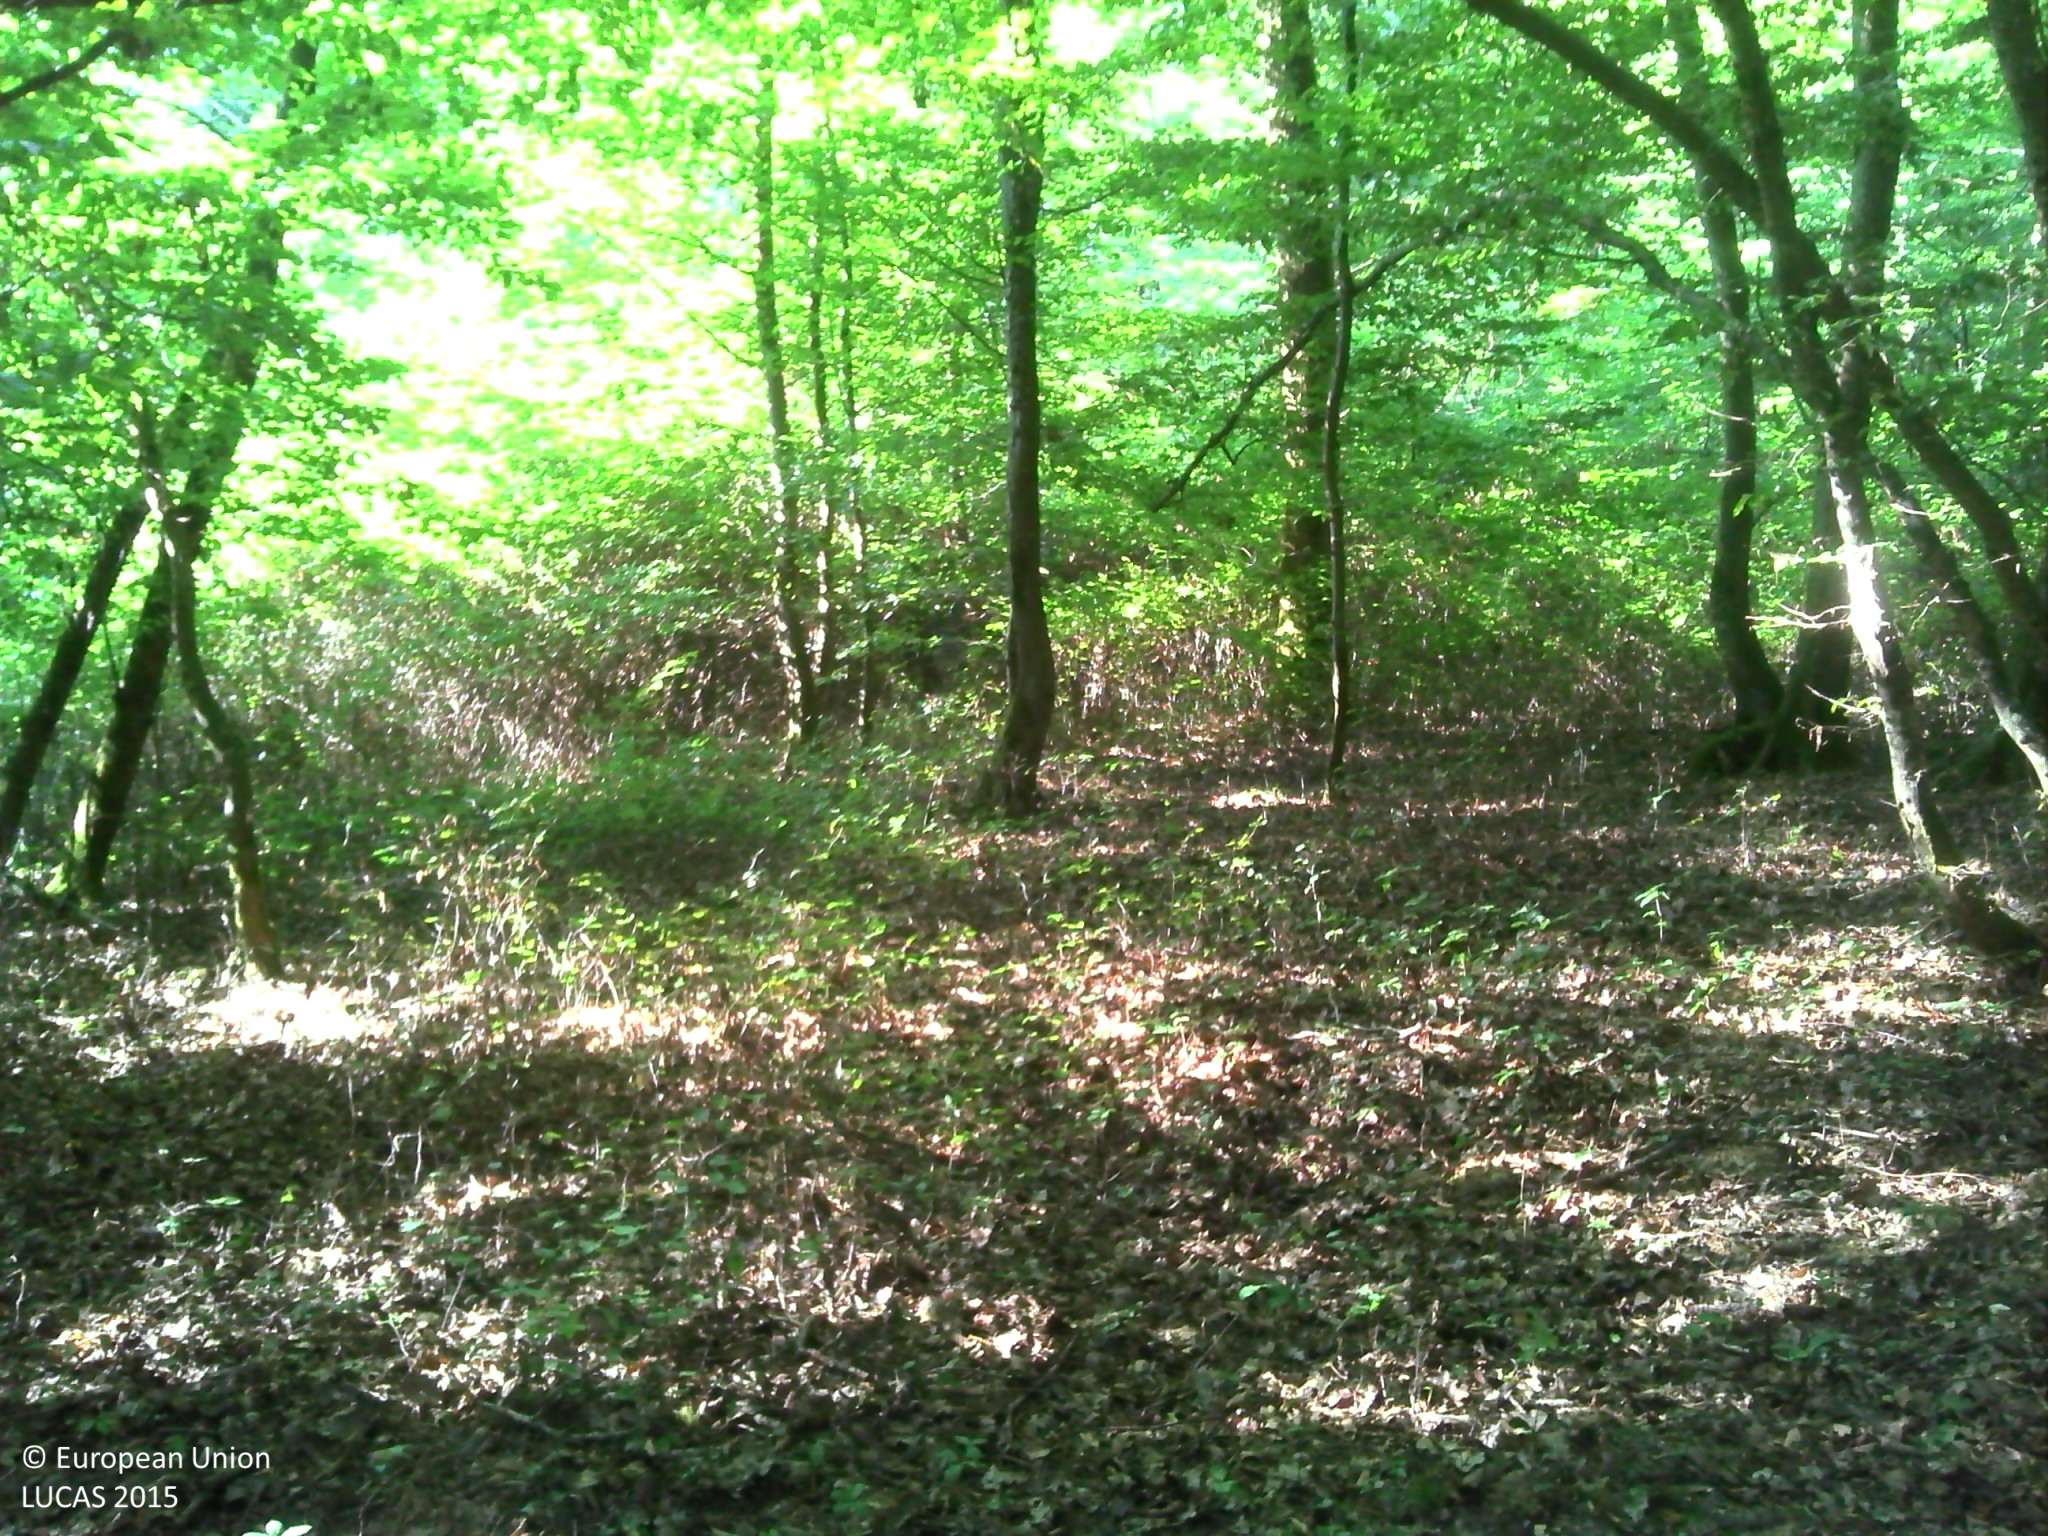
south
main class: Woodland
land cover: Broadleaved woodland
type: mesophytic deciduous forest
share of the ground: > 75 %
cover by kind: broadleaved forest trees 80 %, herbaceous plants 20 %
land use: Semi-natural and natural areas not in use
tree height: > 5 m
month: August
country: FR
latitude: 46.4938
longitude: 4.0723
